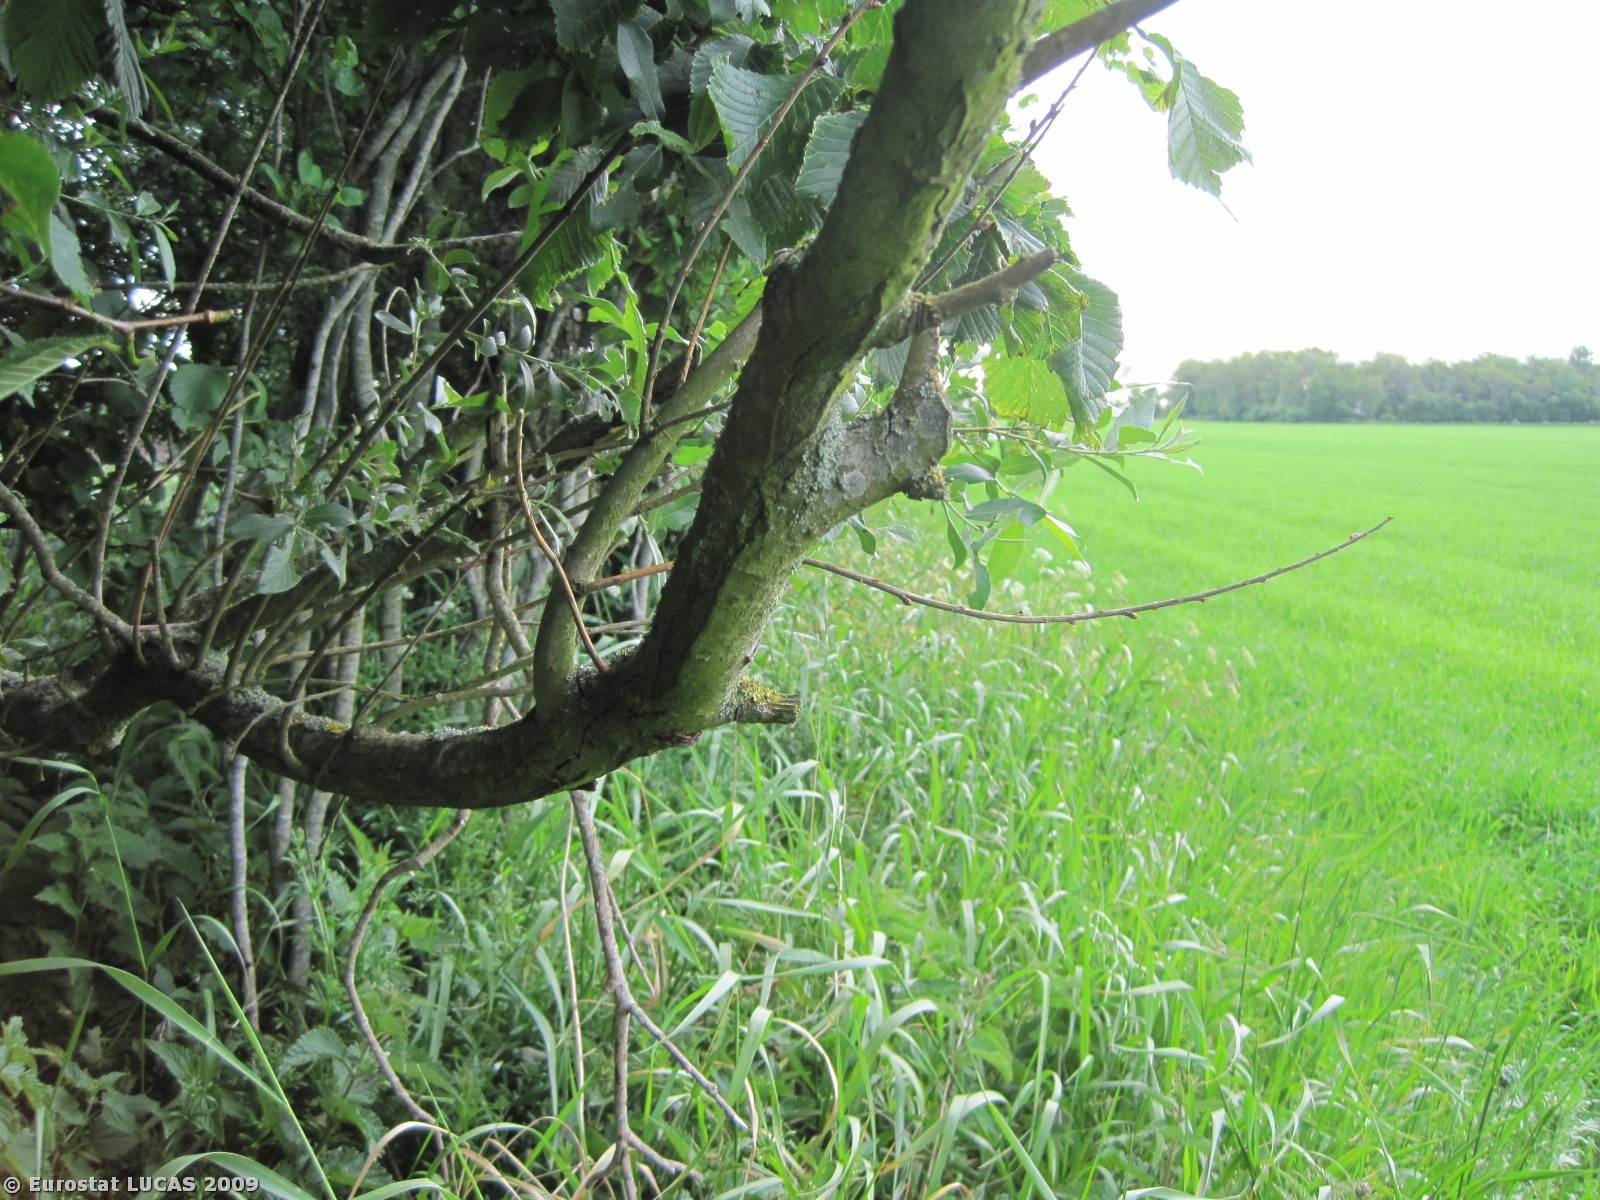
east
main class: Woodland
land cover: Broadleaved woodland
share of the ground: > 75 %
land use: Agriculture (excluding fallow land and kitchen gardens)
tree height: > 5 m
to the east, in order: Broadleaved woodland; Grass margins; Barley
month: June
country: DK
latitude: 57.1943
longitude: 9.7852
